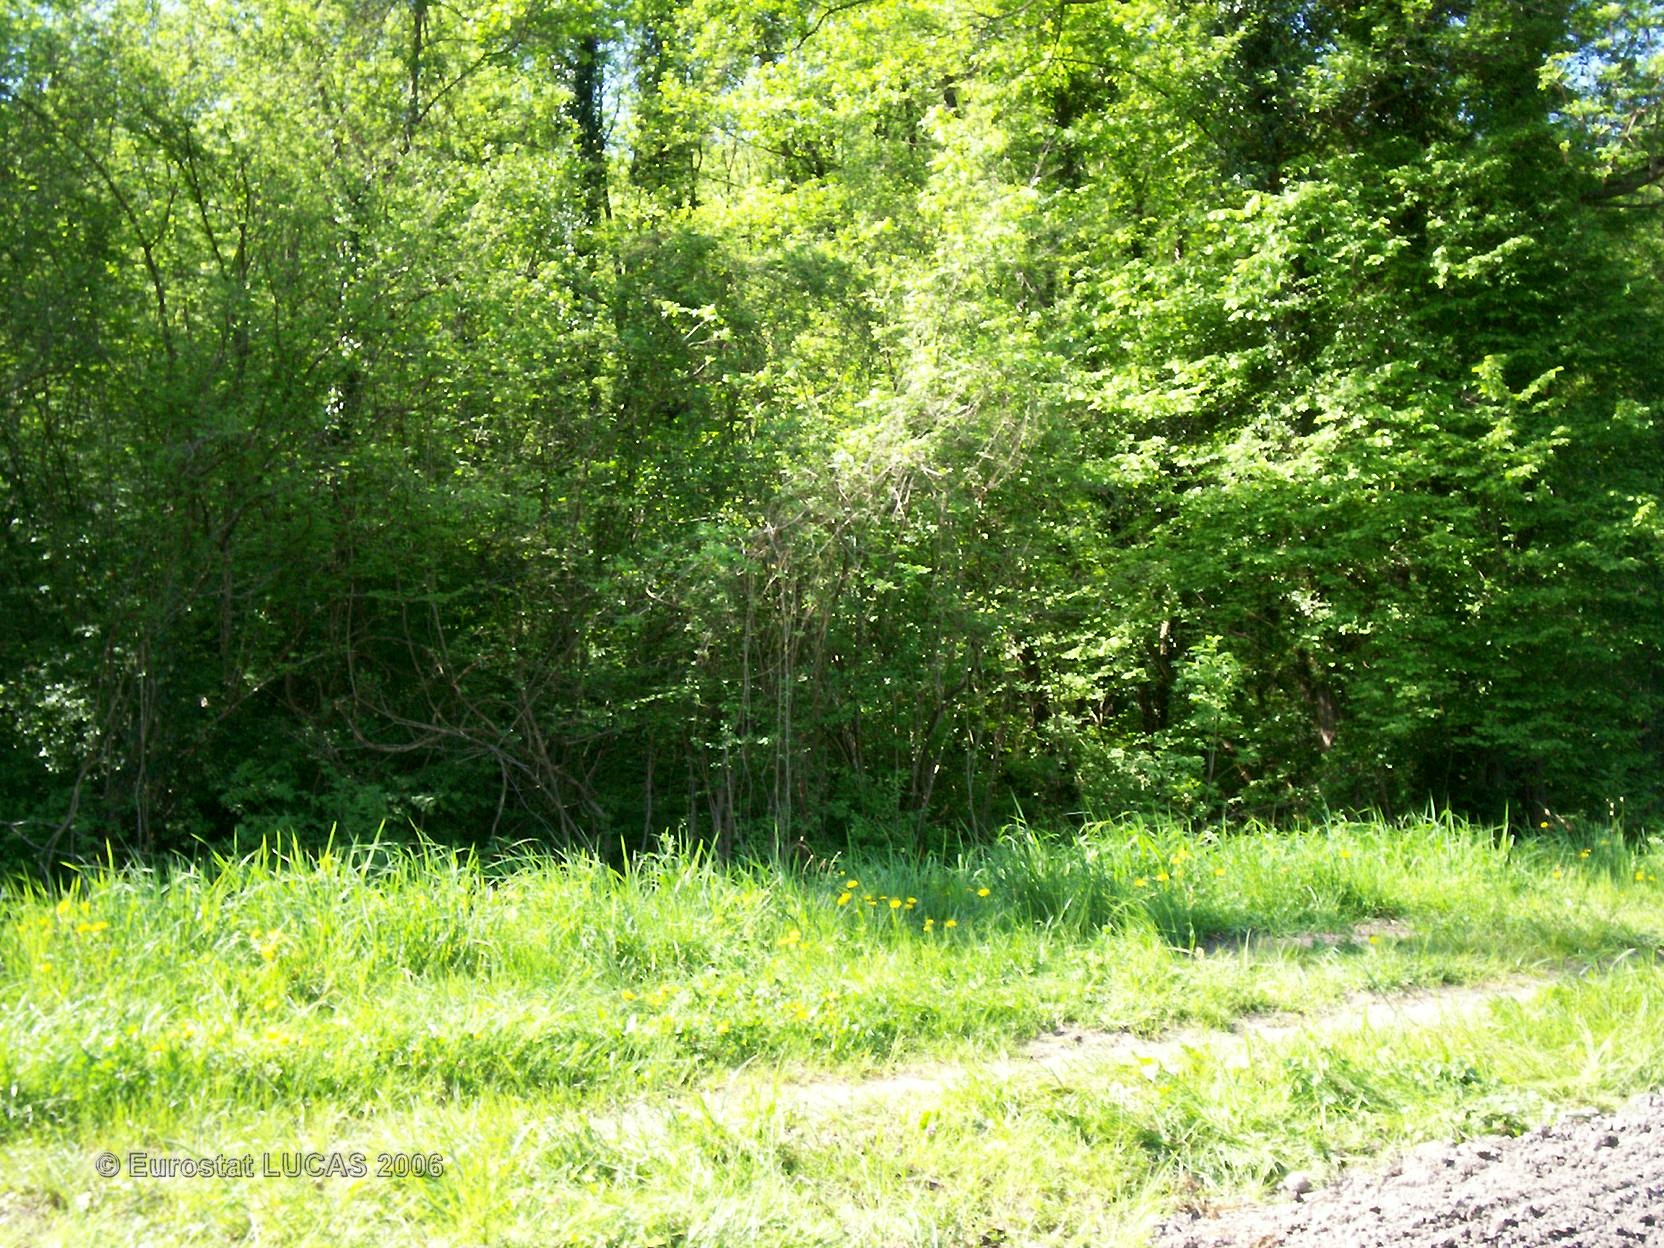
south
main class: Cropland
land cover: Maize
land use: Agriculture (excluding fallow land and kitchen gardens)
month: June
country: FR
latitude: 45.5425
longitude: 6.1496
